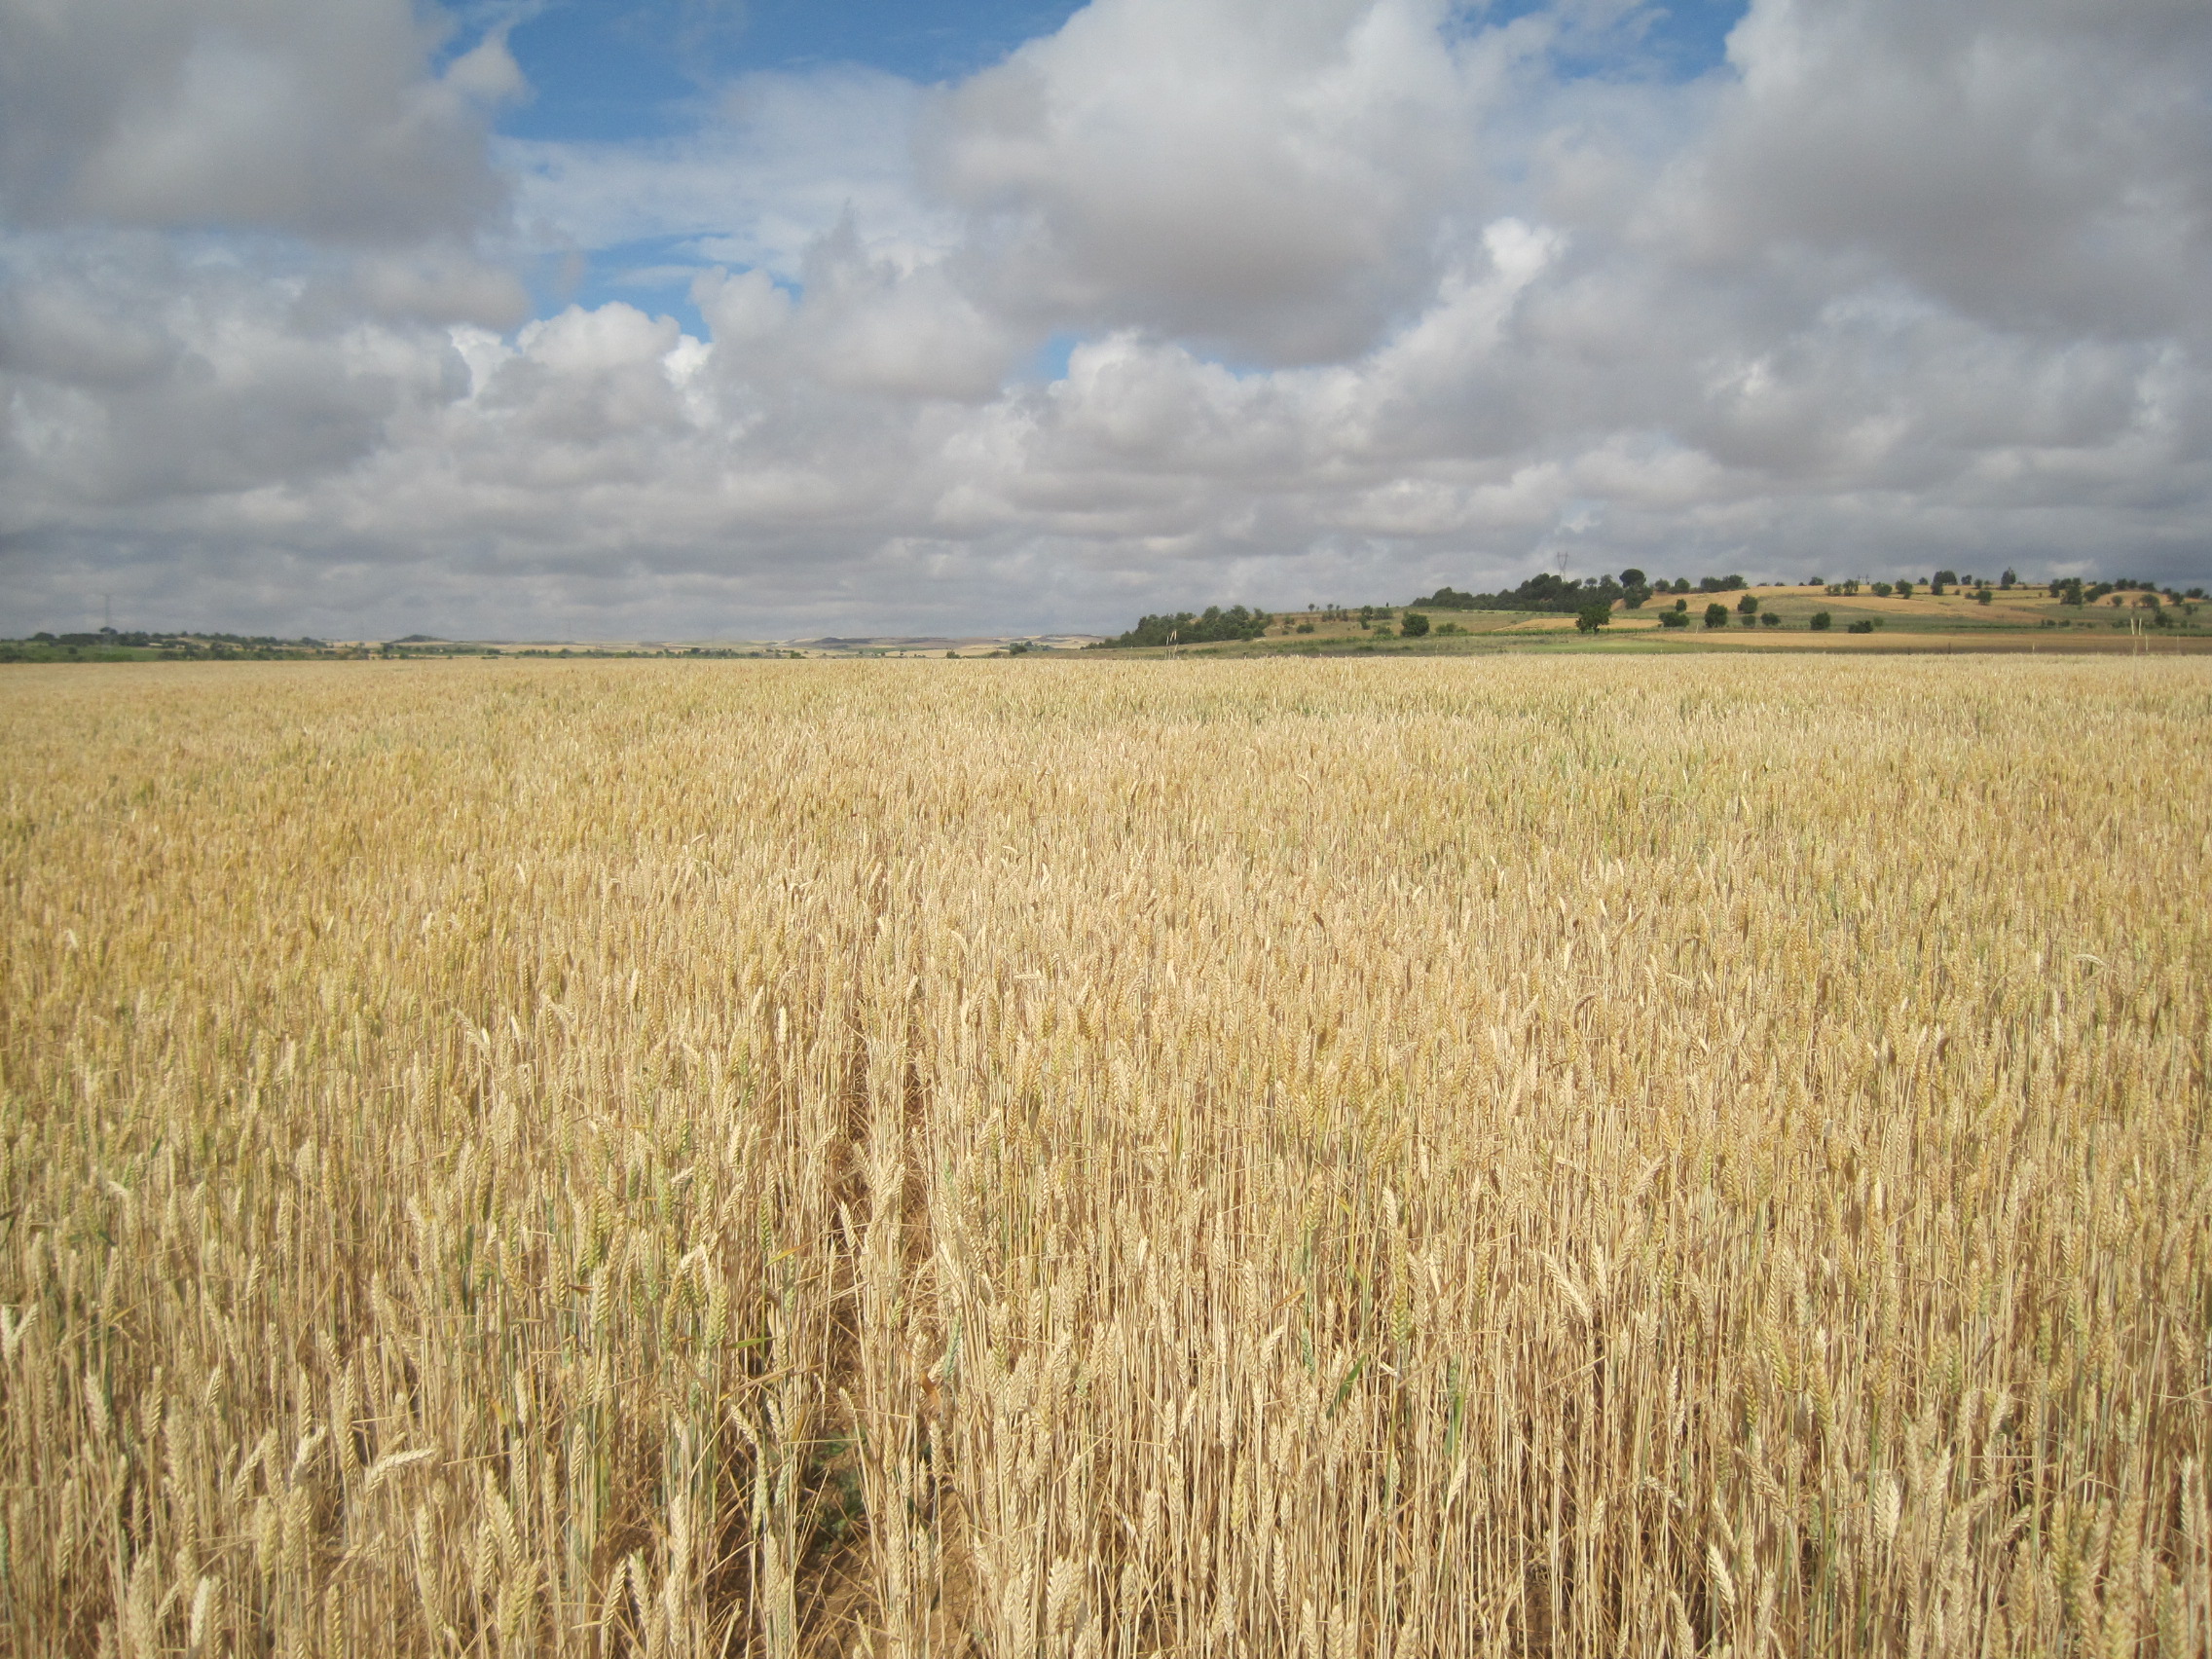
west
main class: Cropland
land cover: Common wheat
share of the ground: > 75 %
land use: Agriculture (excluding fallow land and kitchen gardens)
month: June
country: ES
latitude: 41.7393
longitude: -4.7028
